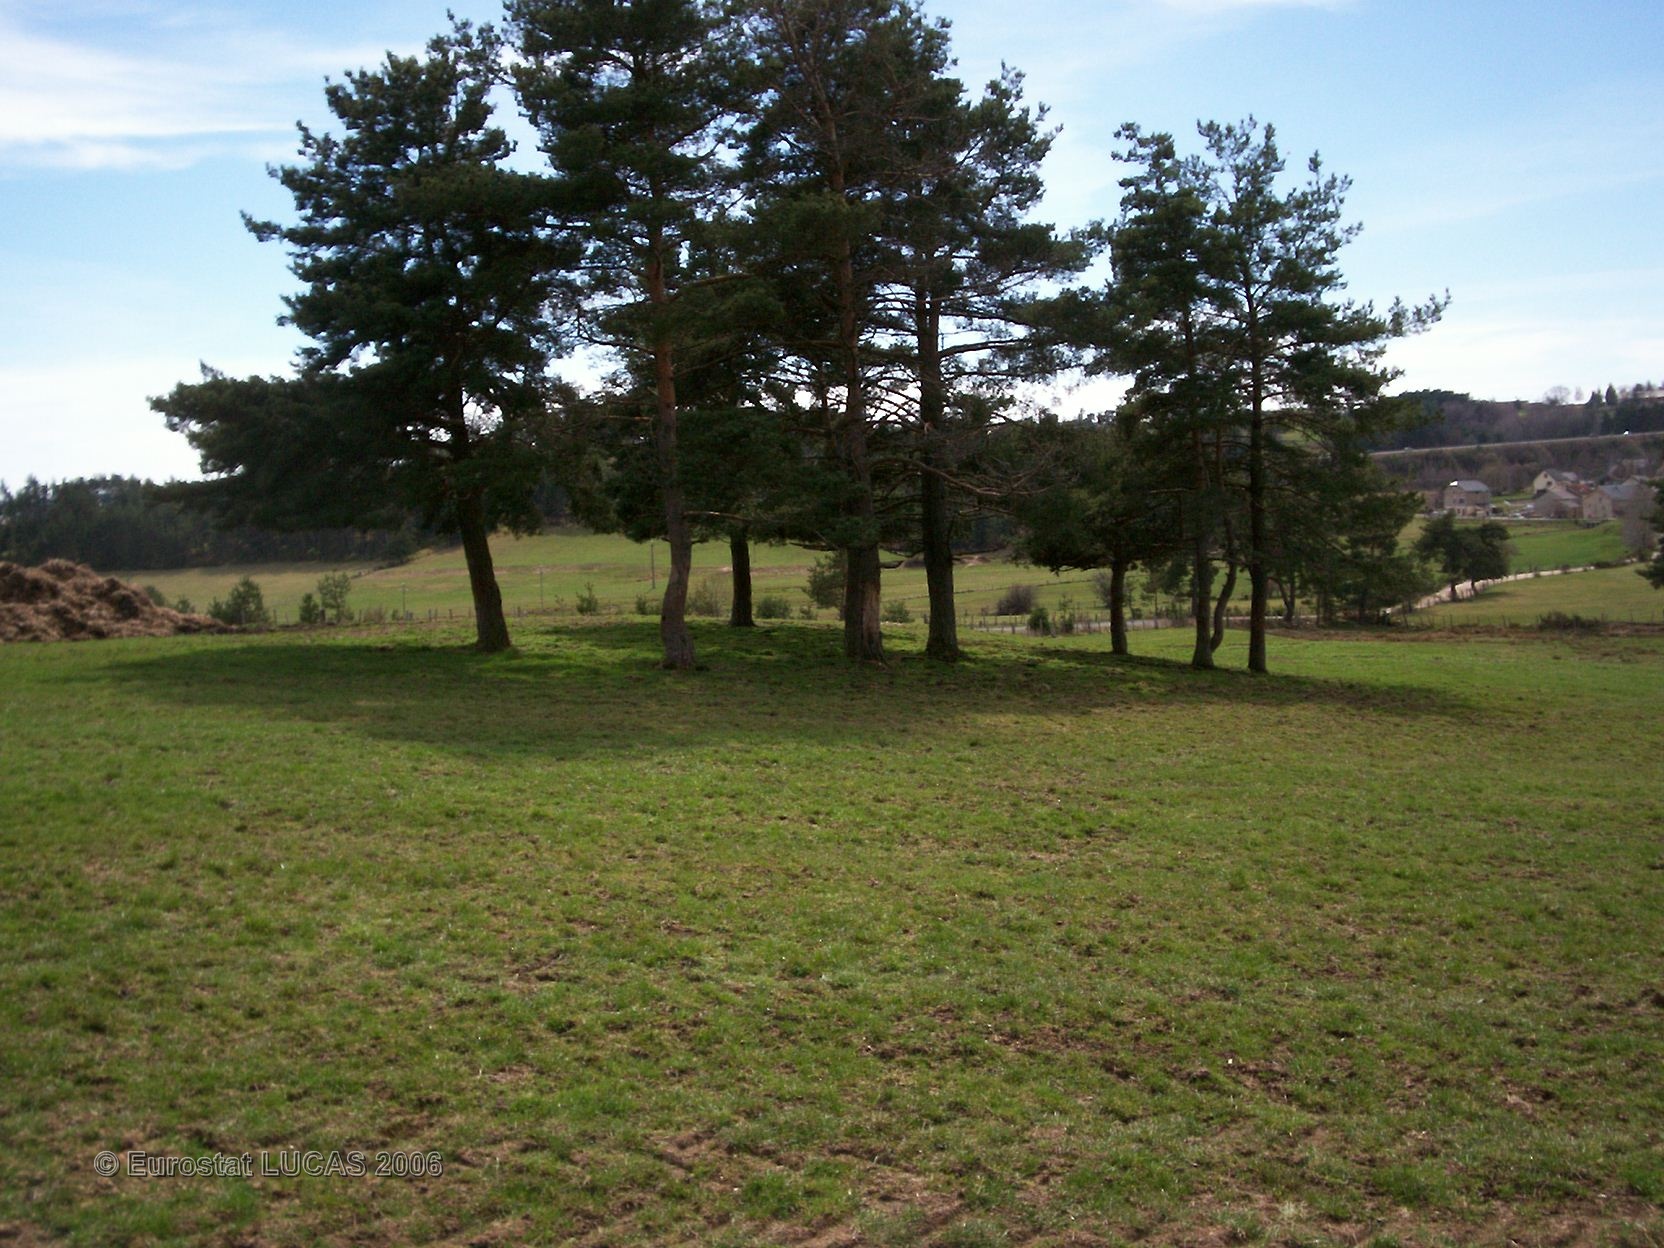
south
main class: Grassland
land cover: Grassland without tree/shrub cover
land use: Agriculture (excluding fallow land and kitchen gardens)
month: April
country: FR
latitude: 44.8206
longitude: 3.2883
